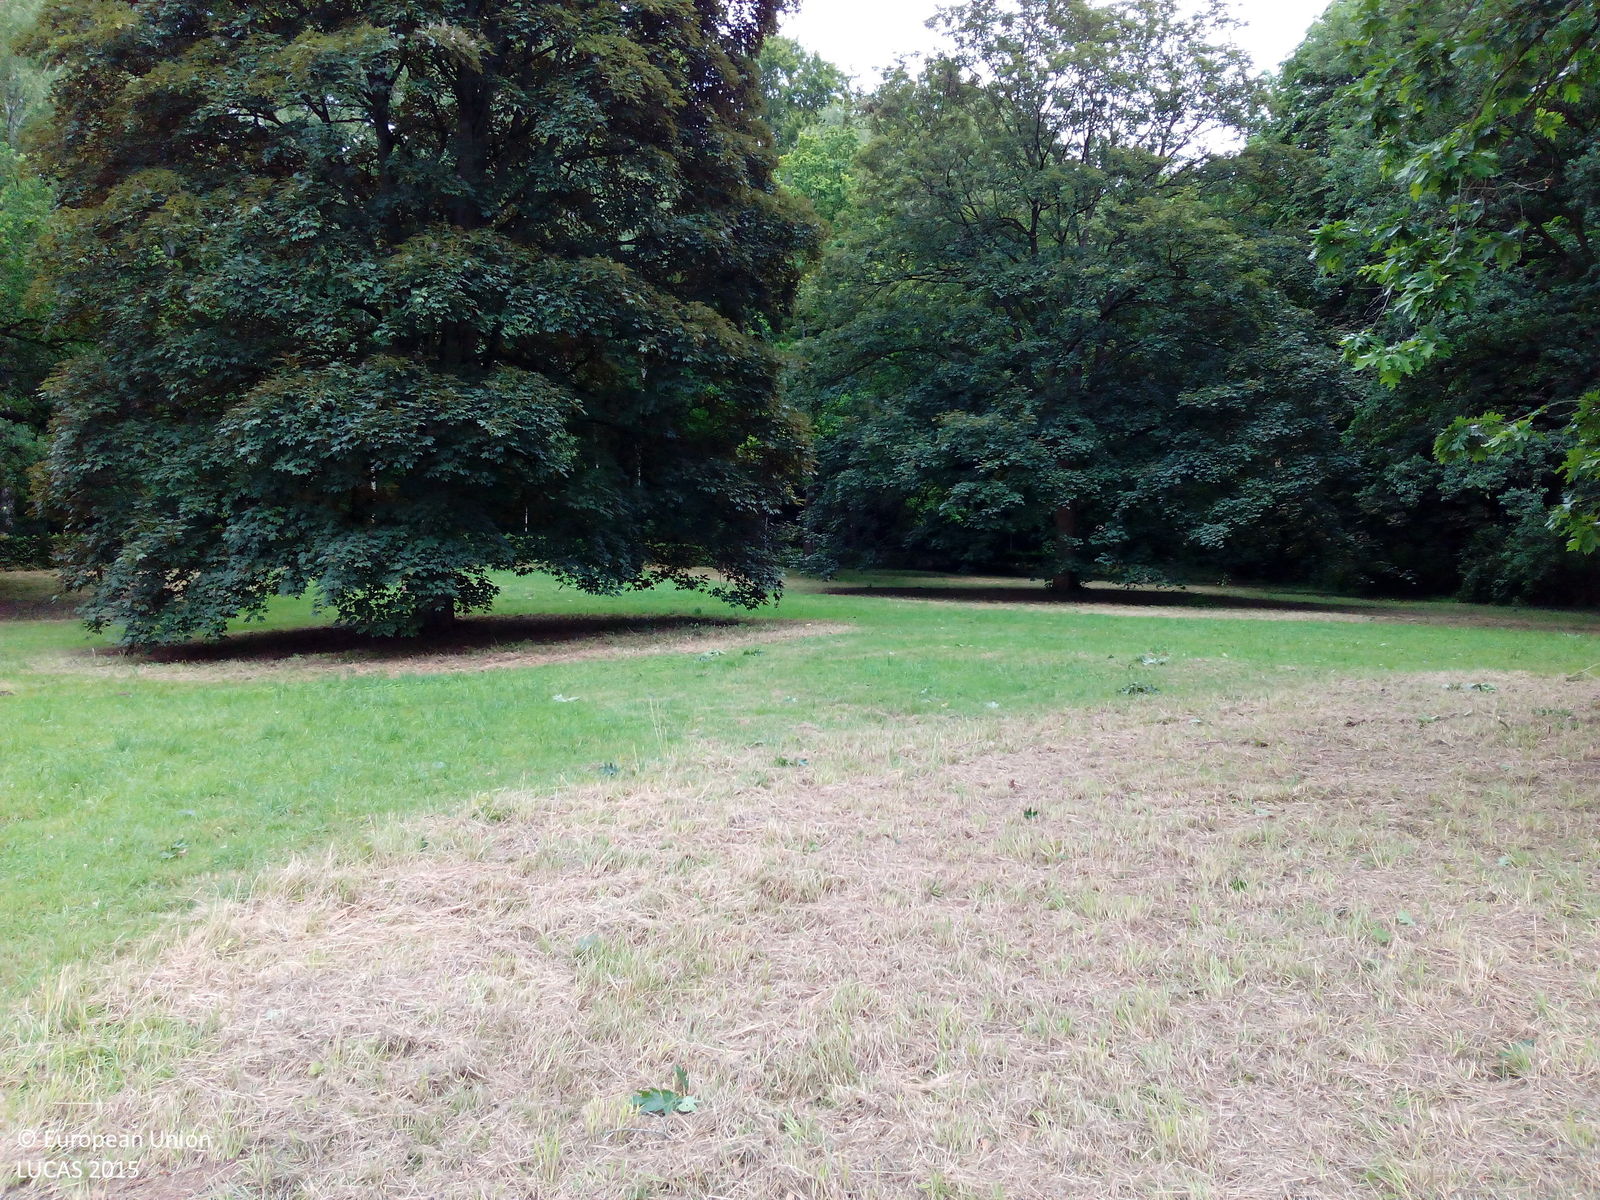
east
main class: Grassland
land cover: Grassland without tree/shrub cover
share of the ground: > 75 %
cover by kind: herbaceous plants 100 %
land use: Community services
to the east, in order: Grassland without tree/shrub cover; Grassland with sparse tree/shrub cover; Managed hedges; Grass margins; Lines of trees; Tracks; Broadleaved woodland; Paved roads, cycling and walking lanes; Ditches and canals; Broadleaved woodland; Tracks; Broadleaved woodland; Shruby margins; Tracks; Broadleaved woodland; Grassland without tree/shrub cover
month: July
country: DE
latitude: 51.5326
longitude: 9.9568
